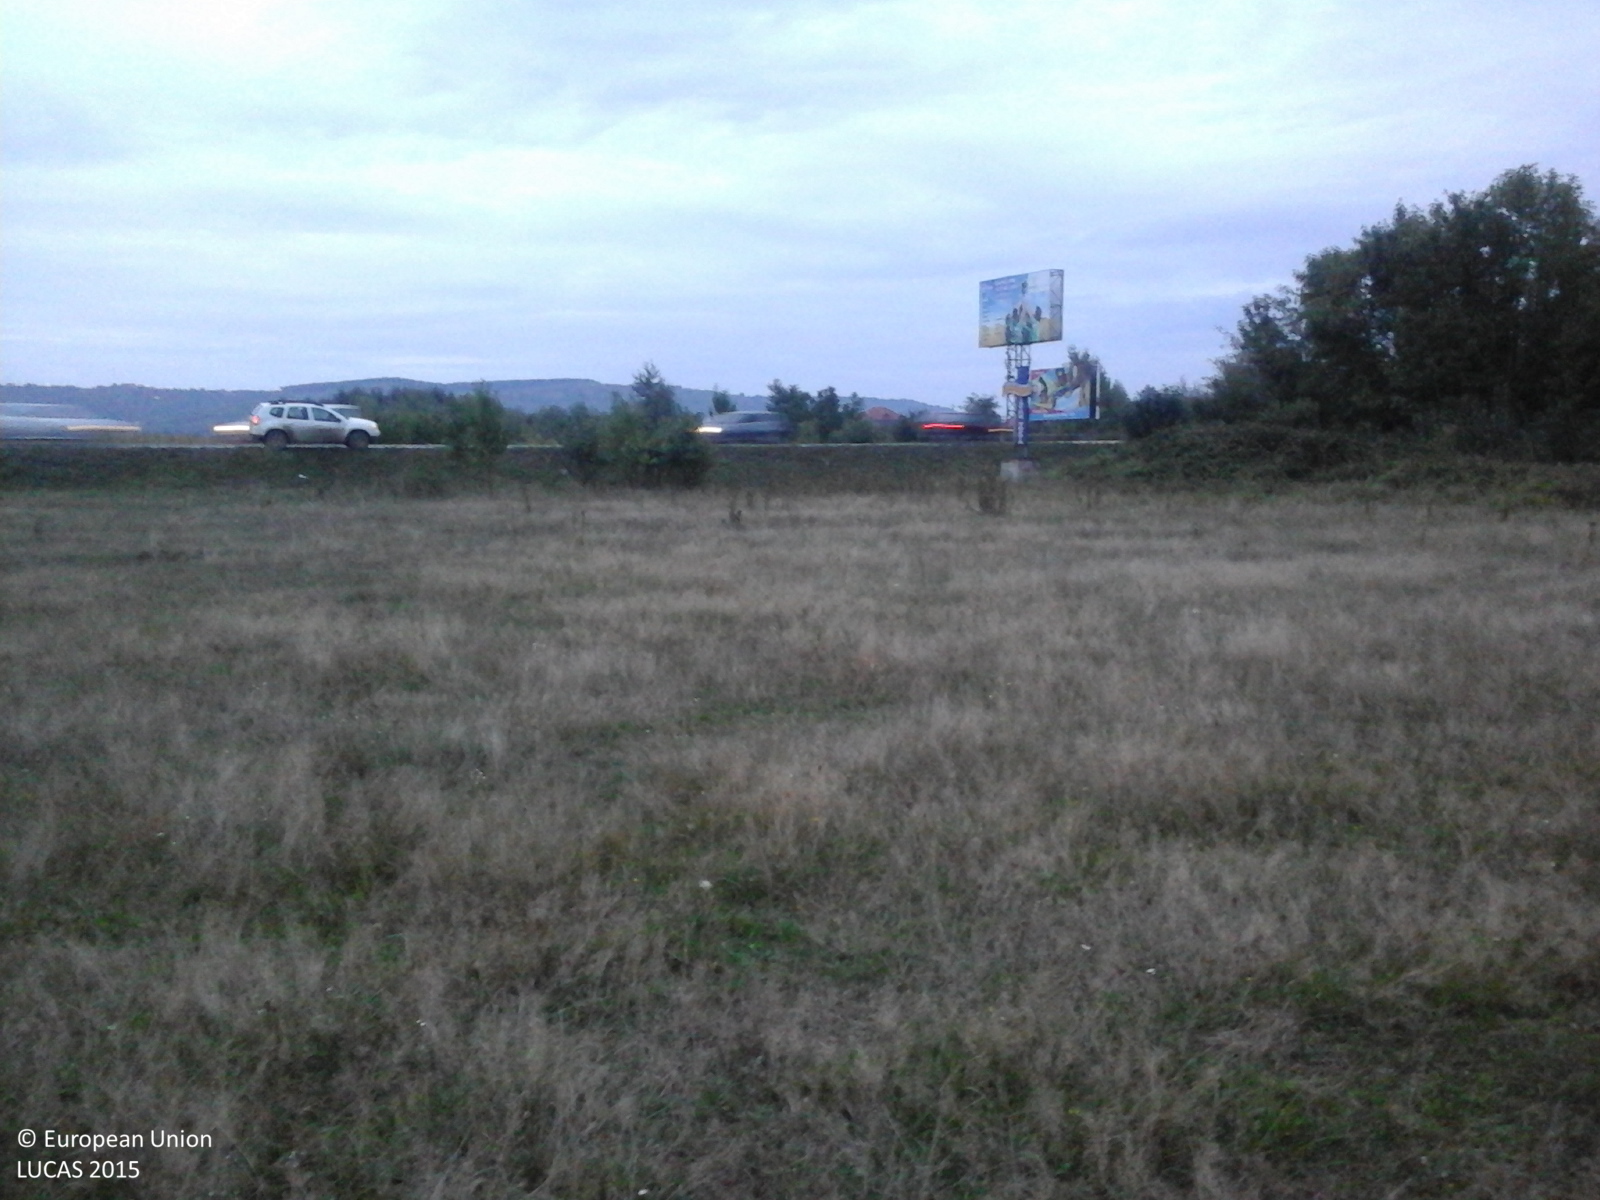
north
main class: Grassland
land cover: Grassland without tree/shrub cover
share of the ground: > 75 %
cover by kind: herbaceous plants 100 %
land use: Agriculture (excluding fallow land and kitchen gardens)
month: September
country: RO
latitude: 47.0366
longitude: 22.0099
